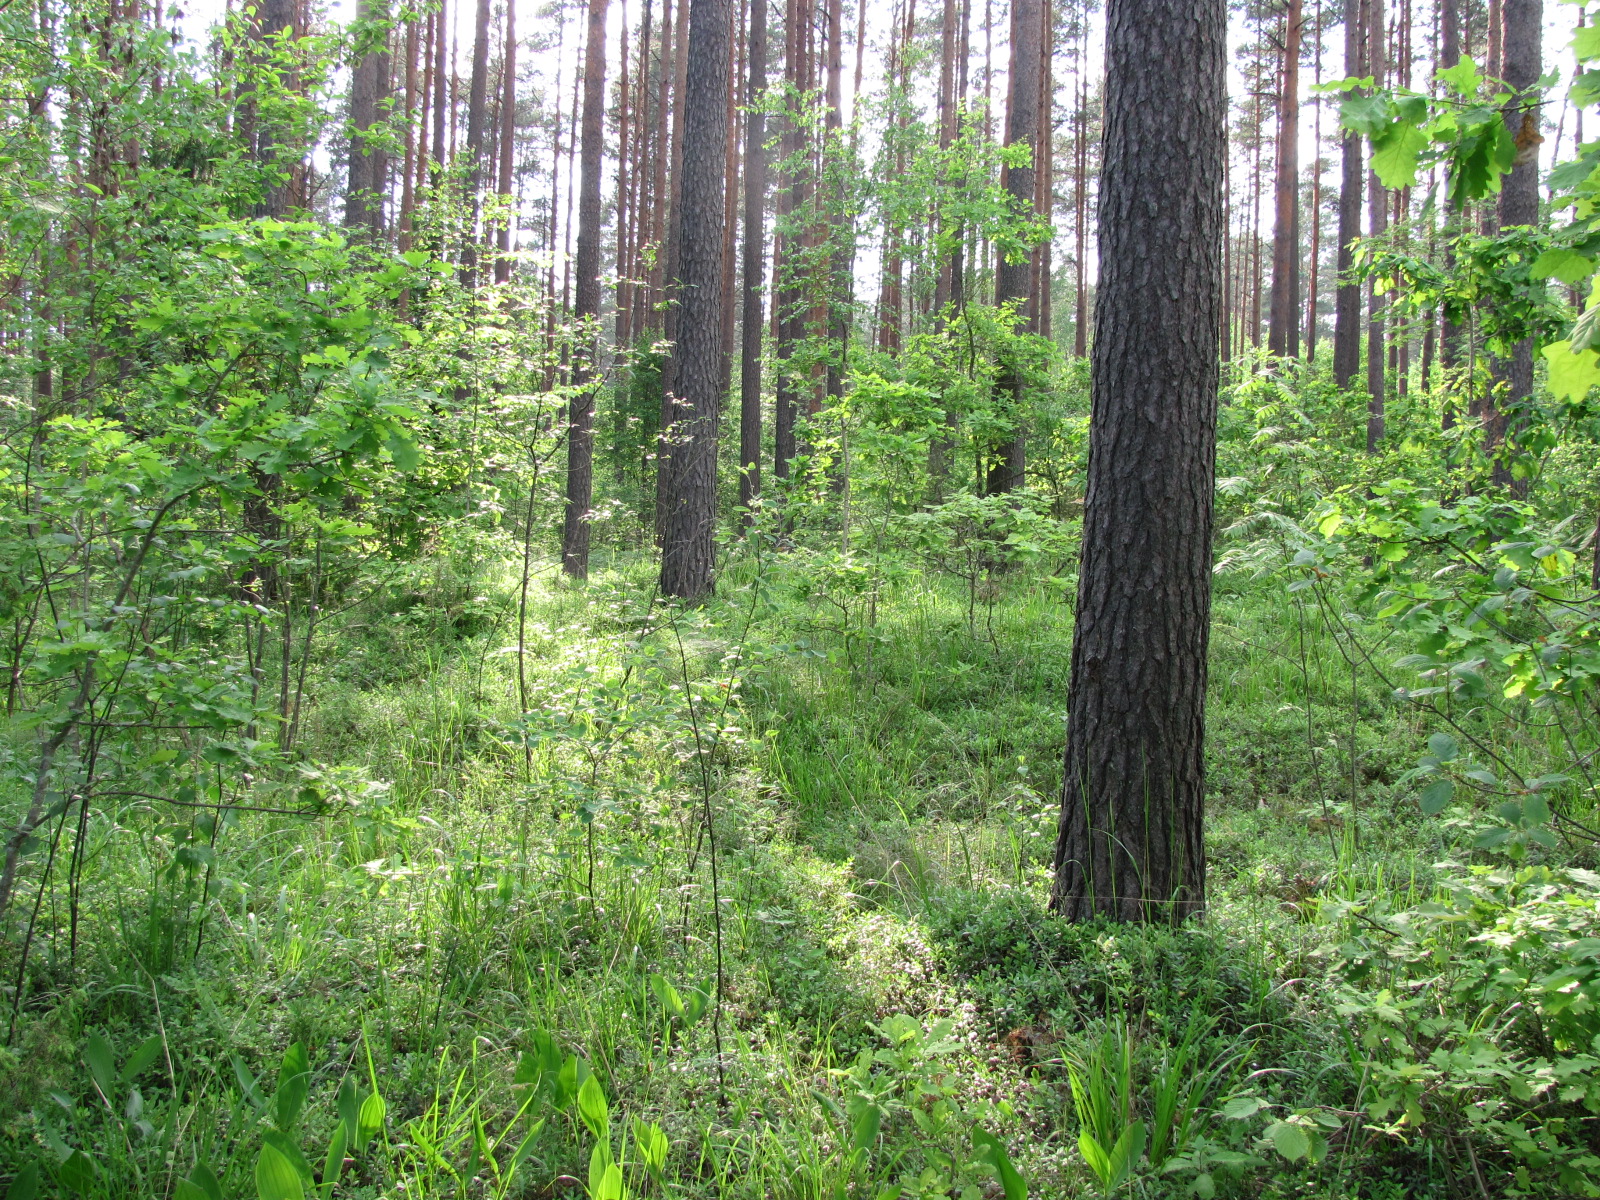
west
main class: Woodland
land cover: Pine dominated mixed woodland
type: hemiboreal forest and nemoral coniferous forest and mixed broadleaved-coniferous forest
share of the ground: > 75 %
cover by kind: coniferous forest trees 60 %, broadleaved forest trees 30 %, herbaceous plants 10 %
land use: Forestry
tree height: > 5 m
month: June
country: LV
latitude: 56.9323
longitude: 24.3376
